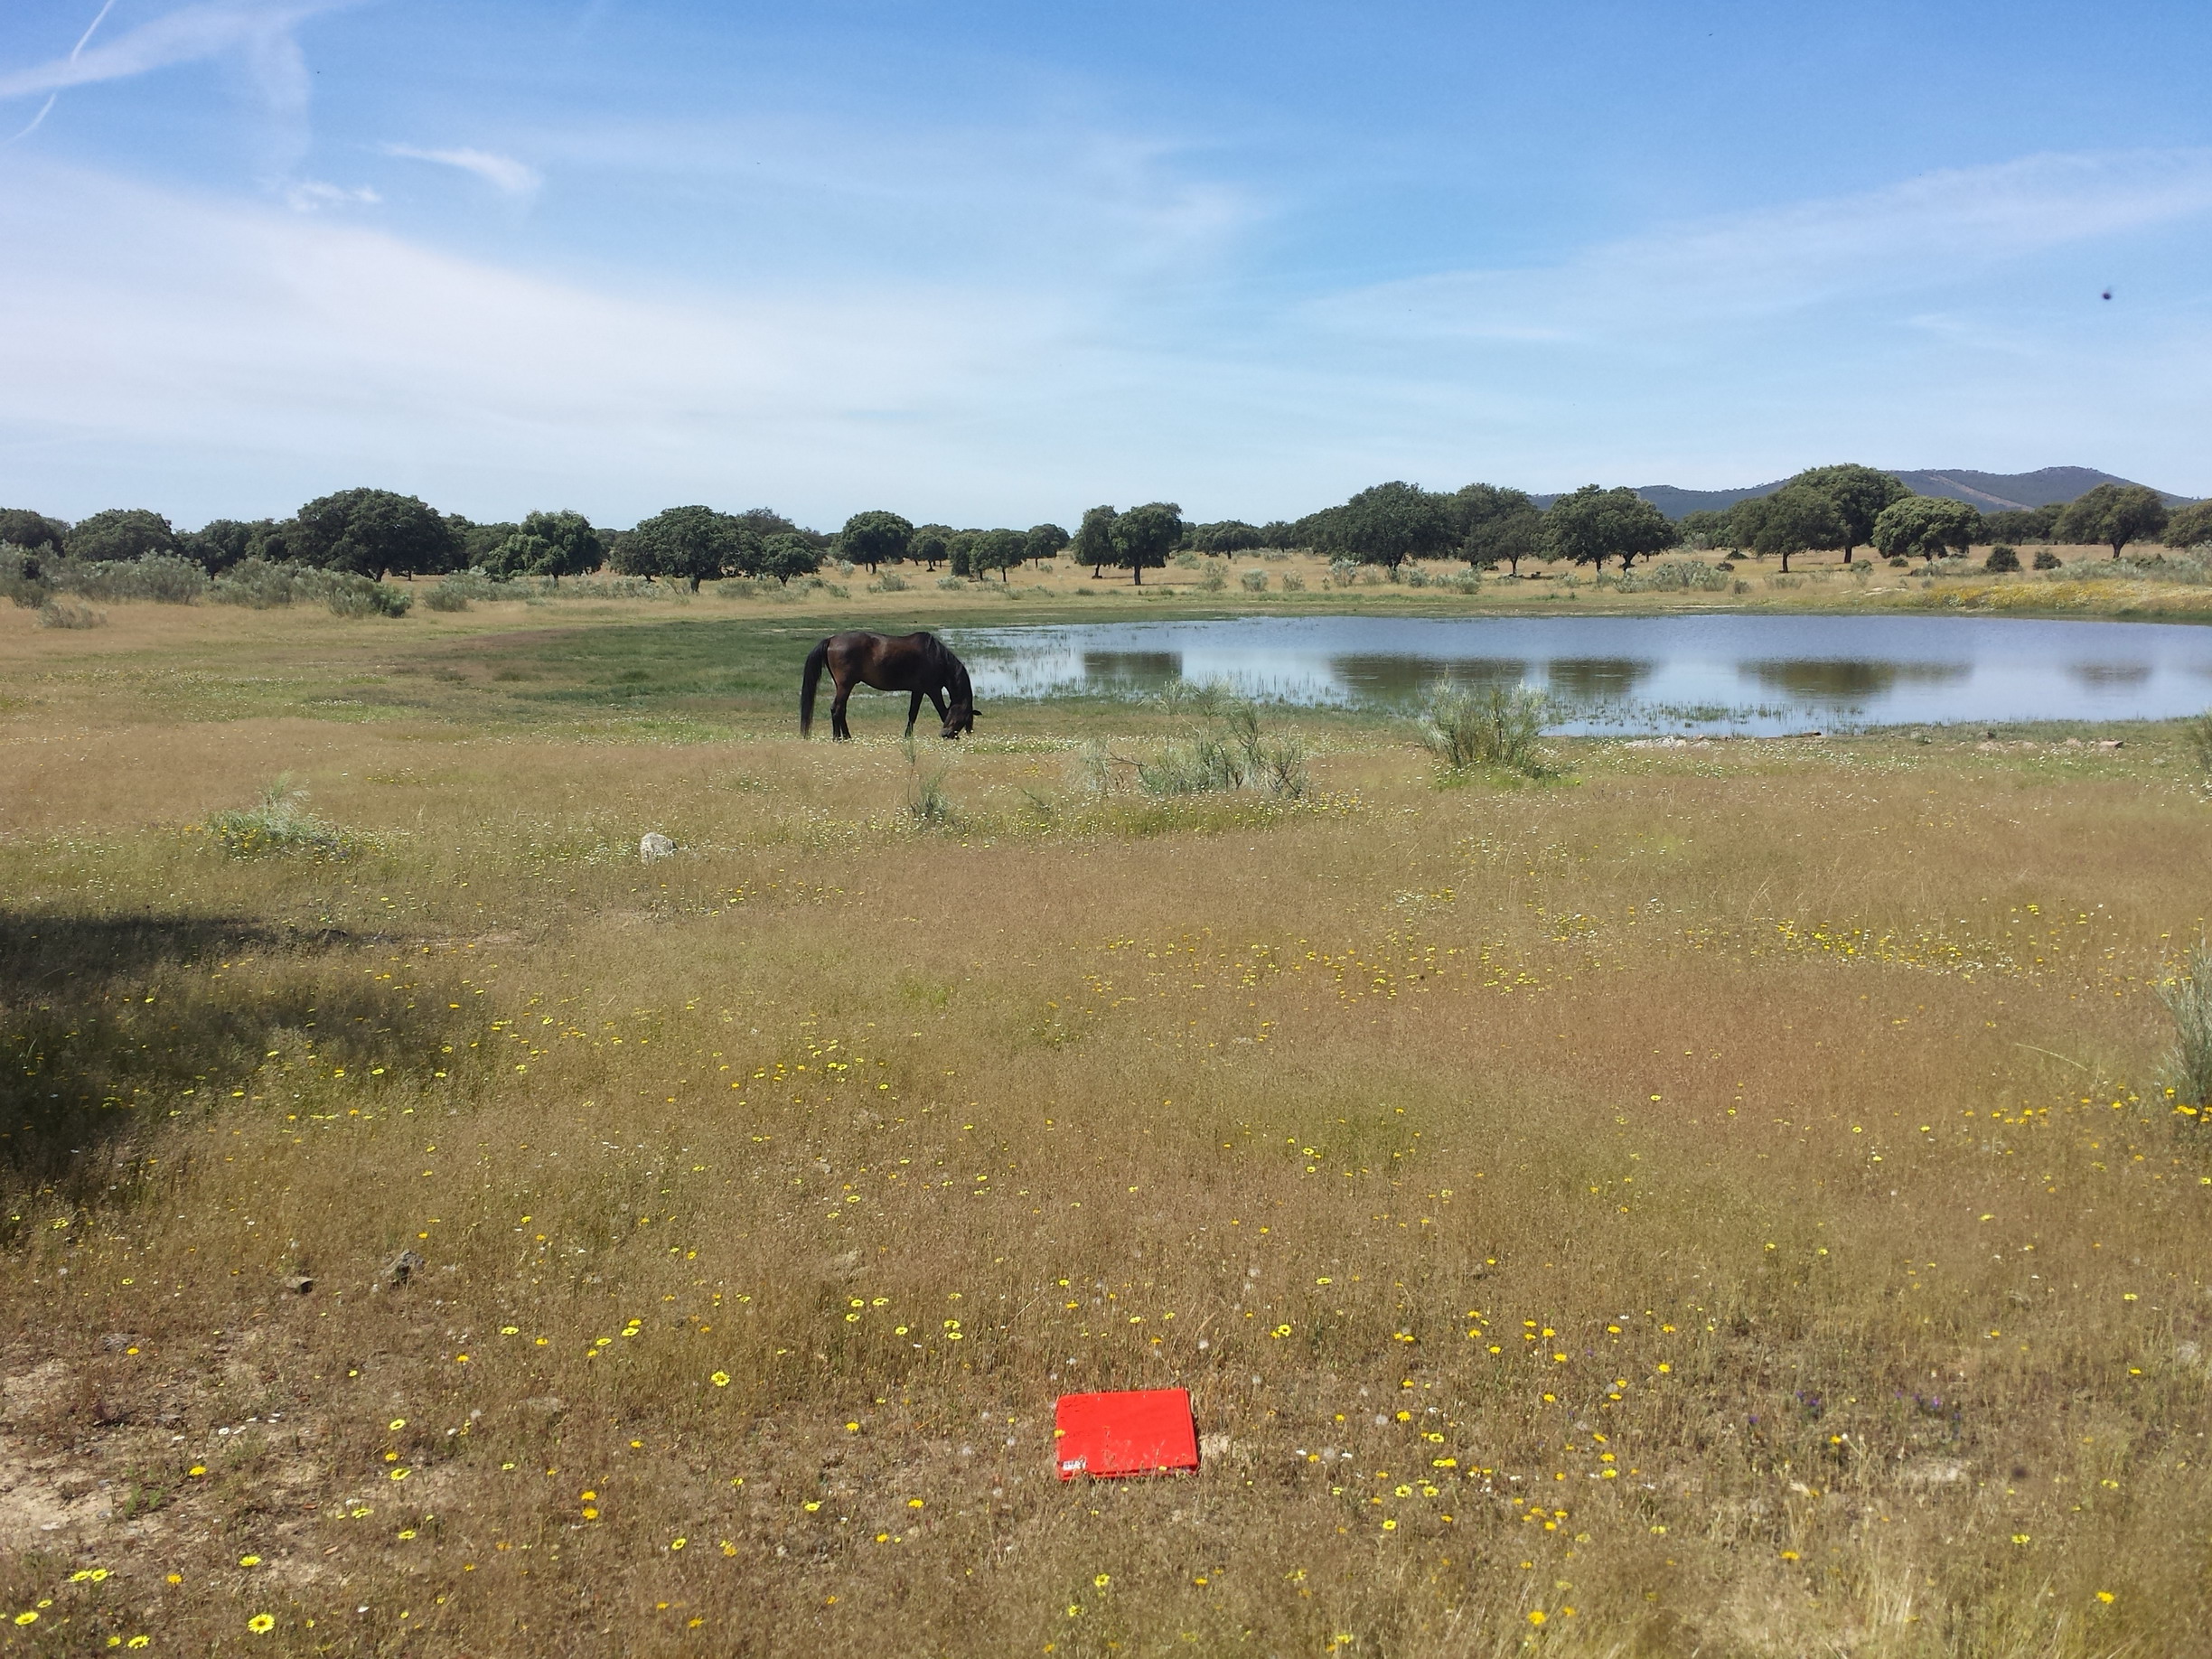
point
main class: Woodland
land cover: Broadleaved woodland
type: broadleaved evergreen forest
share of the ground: 10 - 25 %
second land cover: Grassland without tree/shrub cover
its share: > 75 %
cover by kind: herbaceous plants 85 %, broadleaved forest trees 15 %
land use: Forestry
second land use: Agriculture (excluding fallow land and kitchen gardens)
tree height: > 5 m
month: May
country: ES
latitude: 39.5667
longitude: -7.0911
